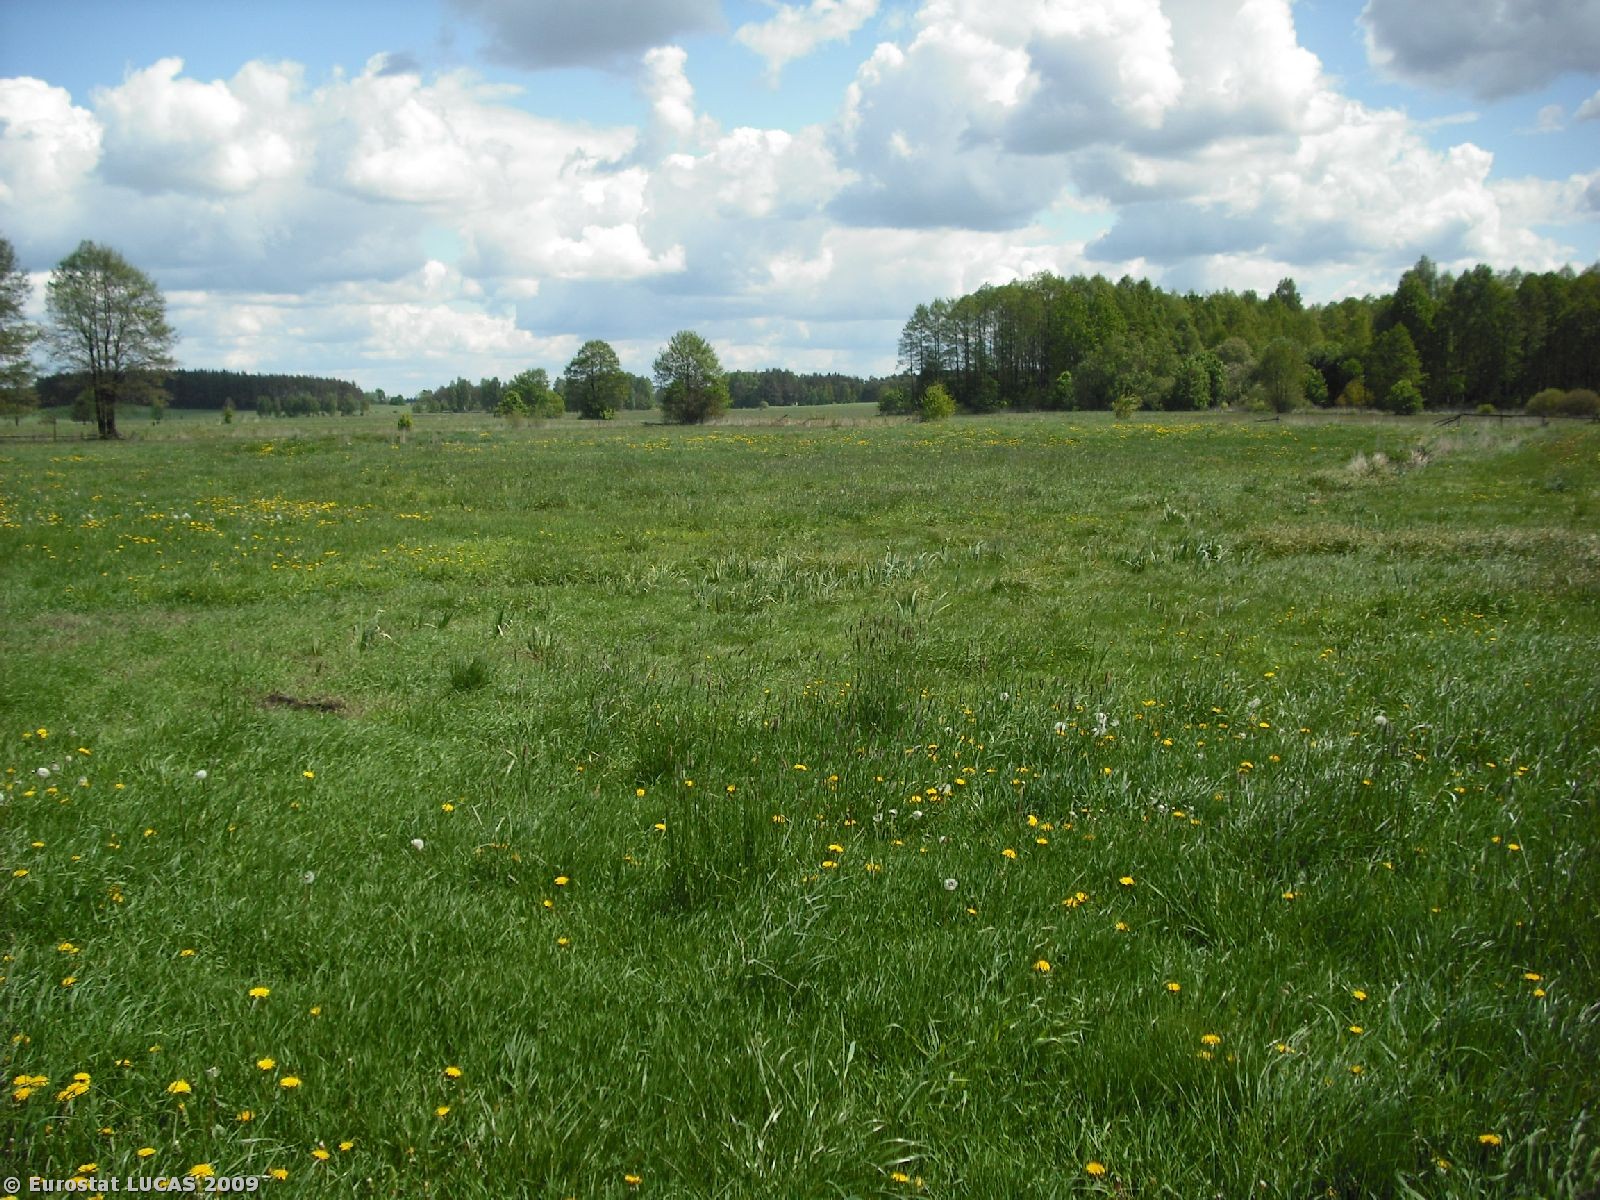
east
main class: Grassland
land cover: Grassland without tree/shrub cover
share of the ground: > 75 %
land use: Agriculture (excluding fallow land and kitchen gardens)
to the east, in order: Grassland without tree/shrub cover; Ditches and canals; Grassland without tree/shrub cover; Ditches and canals; Grassland without tree/shrub cover
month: May
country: PL
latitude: 52.9903
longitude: 22.4750
